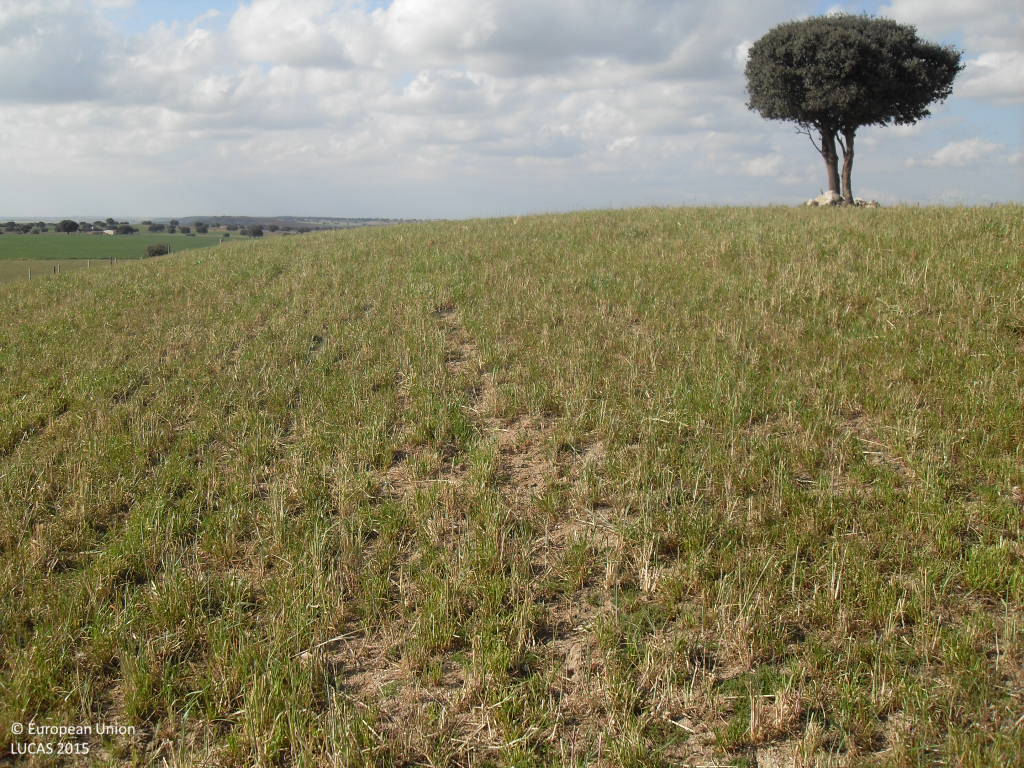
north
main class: Cropland
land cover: Rye
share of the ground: > 75 %
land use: Agriculture (excluding fallow land and kitchen gardens)
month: April
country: ES
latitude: 40.7265
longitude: -5.3288
